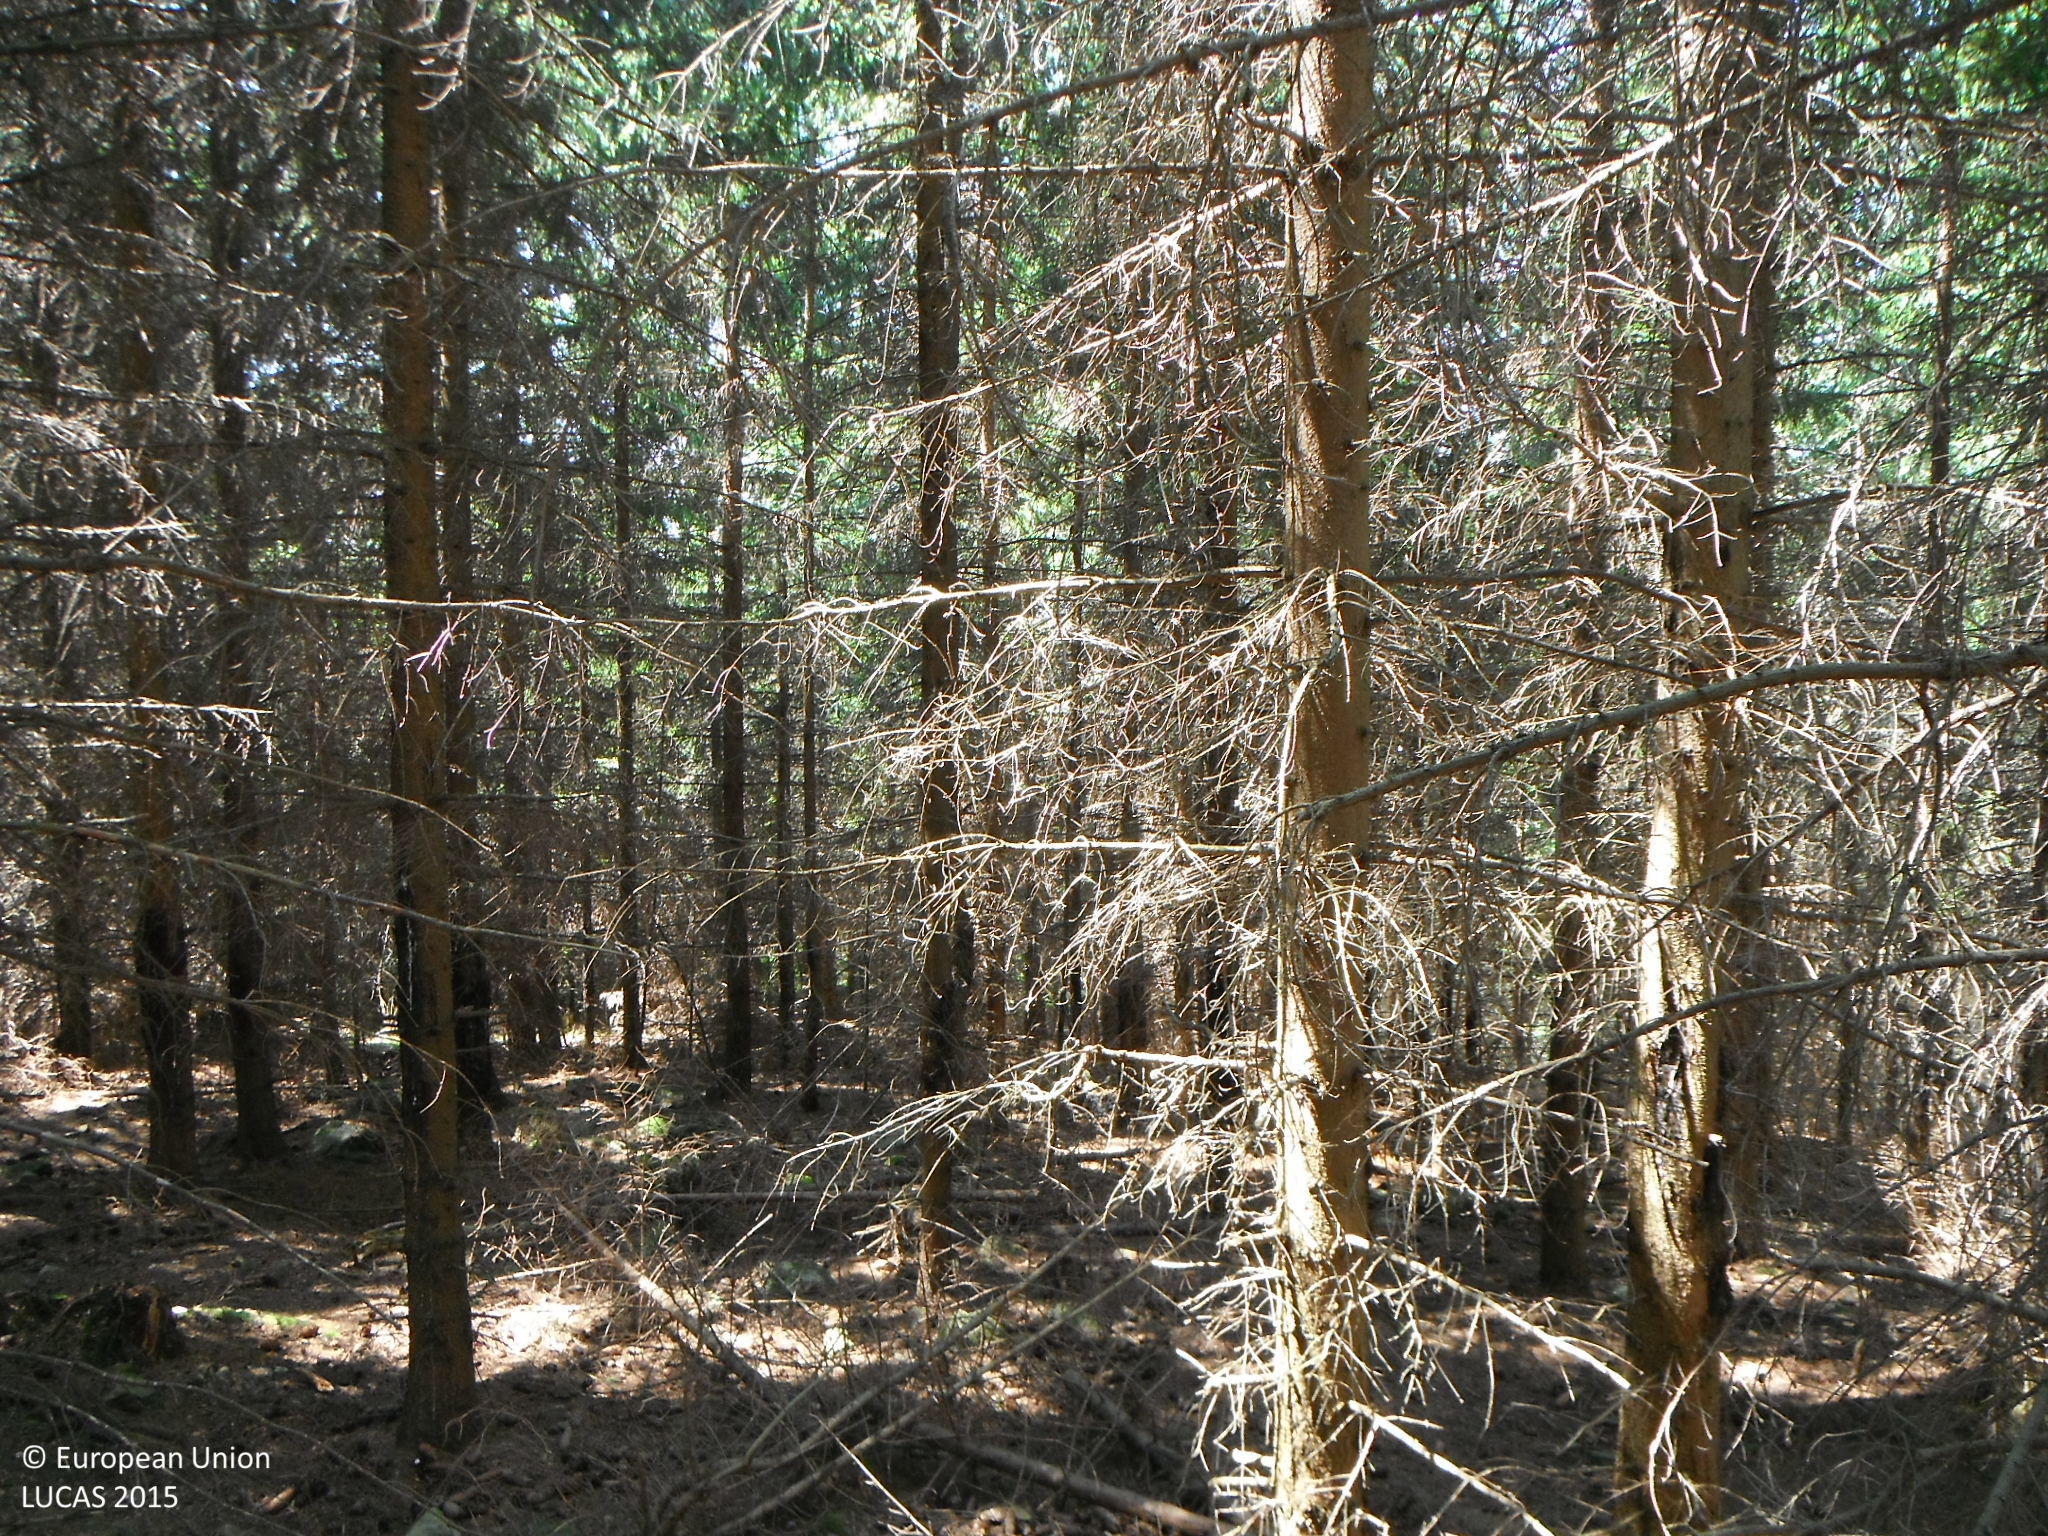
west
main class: Woodland
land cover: Spruce dominated coniferous woodland
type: alpine coniferous forest
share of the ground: > 75 %
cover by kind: coniferous forest trees 100 %
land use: Forestry
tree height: > 5 m
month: June
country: SK
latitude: 48.7142
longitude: 19.3338
